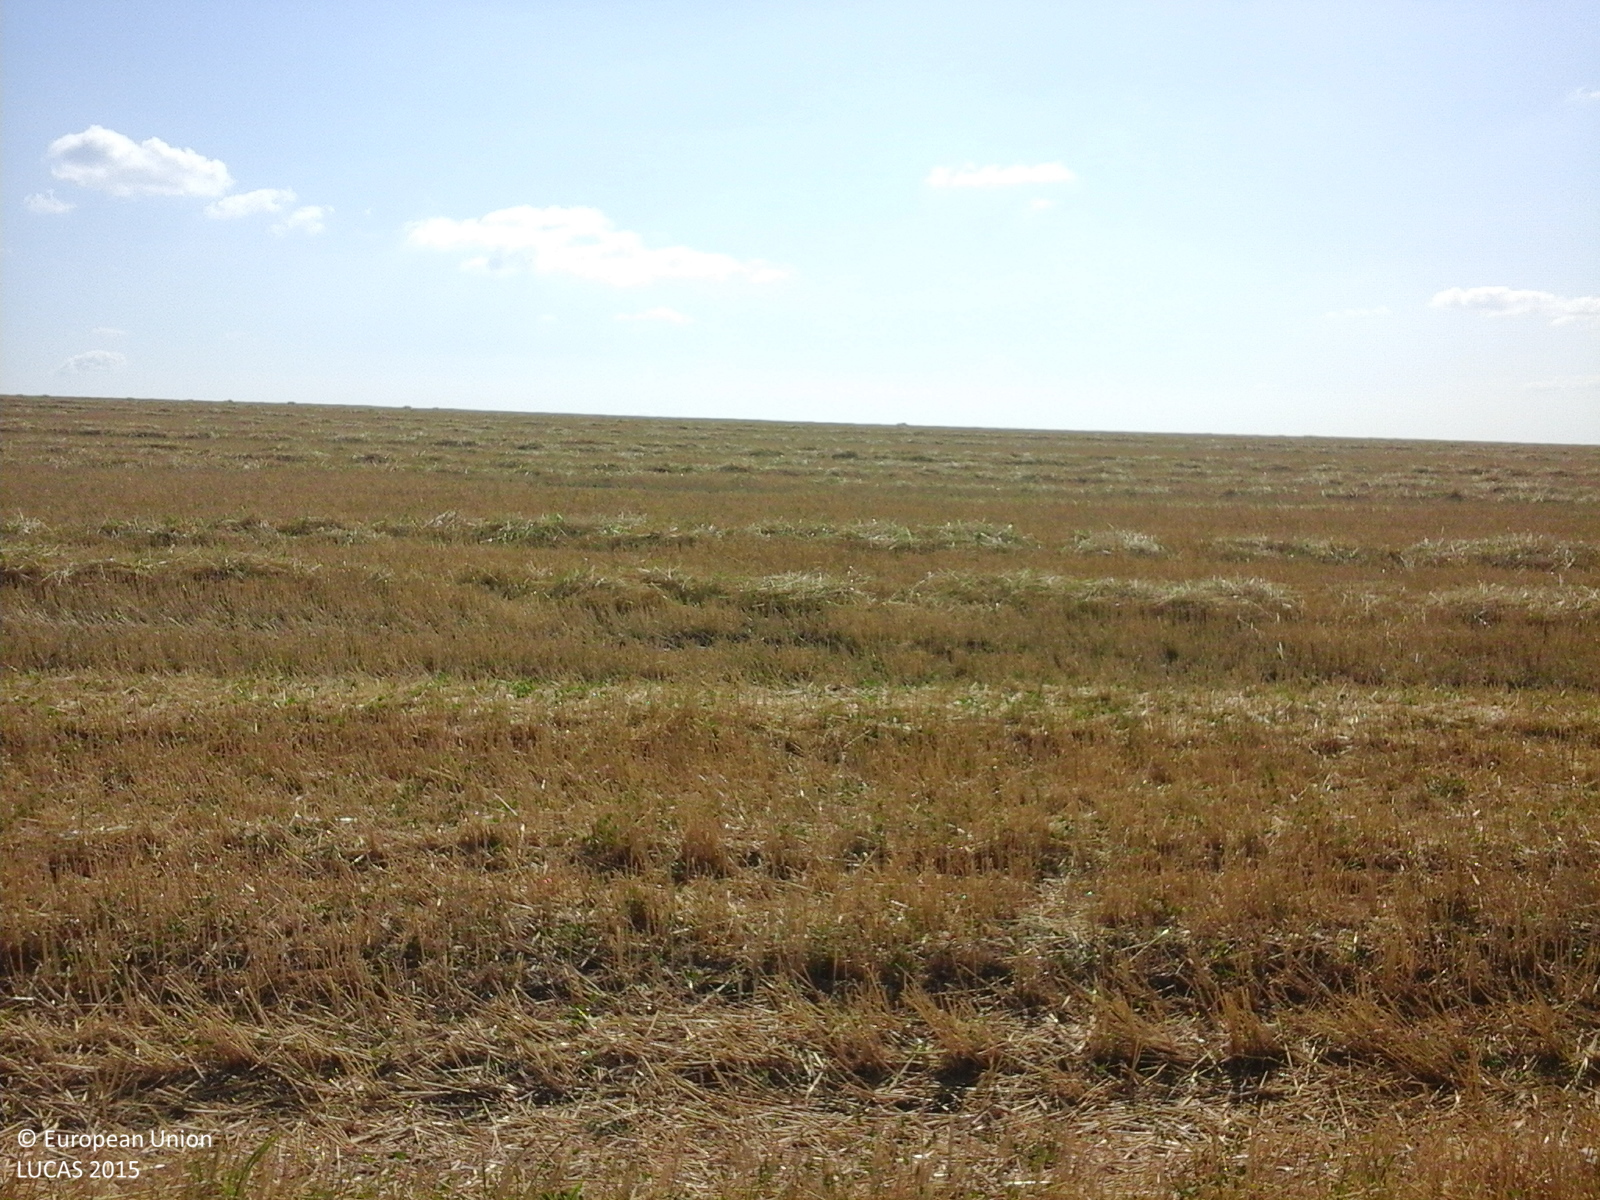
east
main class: Cropland
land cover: Common wheat
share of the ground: > 75 %
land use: Agriculture (excluding fallow land and kitchen gardens)
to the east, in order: Common wheat
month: July
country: RO
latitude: 46.3530
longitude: 28.1278
